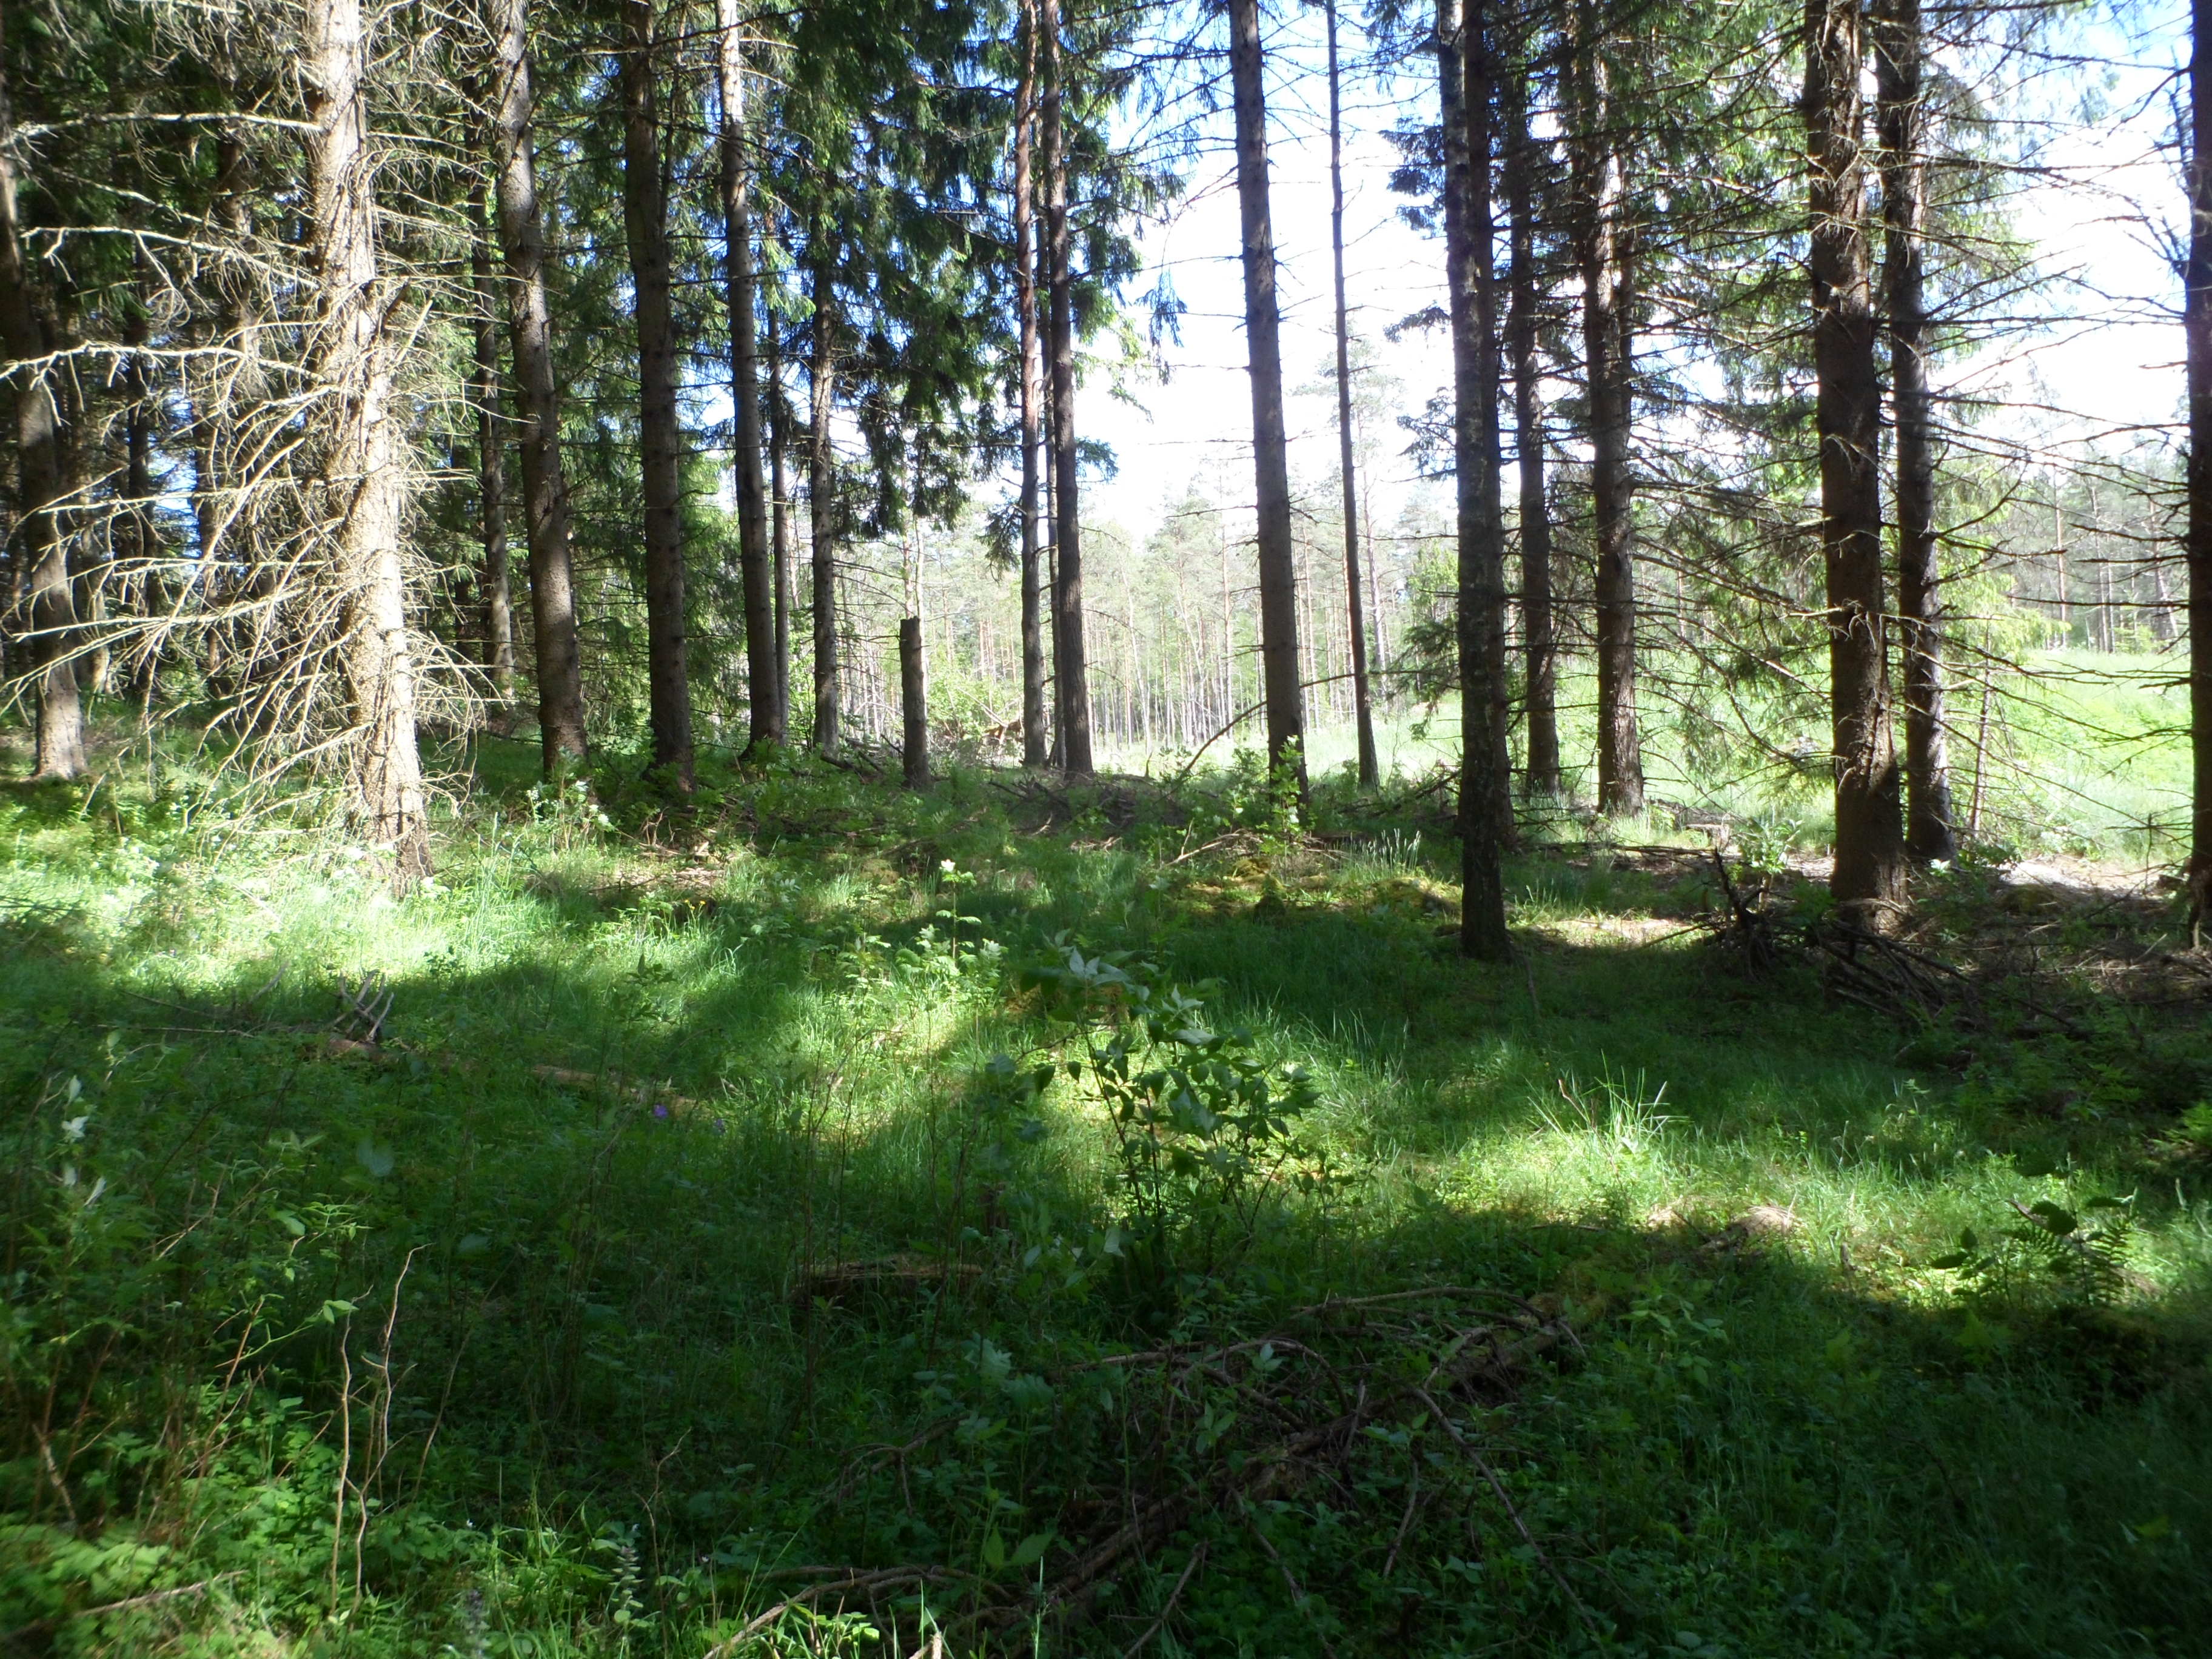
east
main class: Woodland
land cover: Spruce dominated coniferous woodland
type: boreal forest
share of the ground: 50 - 75 %
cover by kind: coniferous forest trees 60 %, herbaceous plants 20 %, shrubs 10 %, broadleaved forest trees 5 %, lichens and mosses 5 %
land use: Forestry
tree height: > 5 m
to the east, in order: Spruce dominated coniferous woodland; Grassland with sparse tree/shrub cover; Pine dominated coniferous woodland; Pine dominated mixed woodland; Ditches and canals; Pine dominated mixed woodland; Ditches and canals; Broadleaved woodland; Ditches and canals; Grassland with sparse tree/shrub cover; Pine dominated mixed woodland
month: June
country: SE
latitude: 57.5060
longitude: 14.1847
